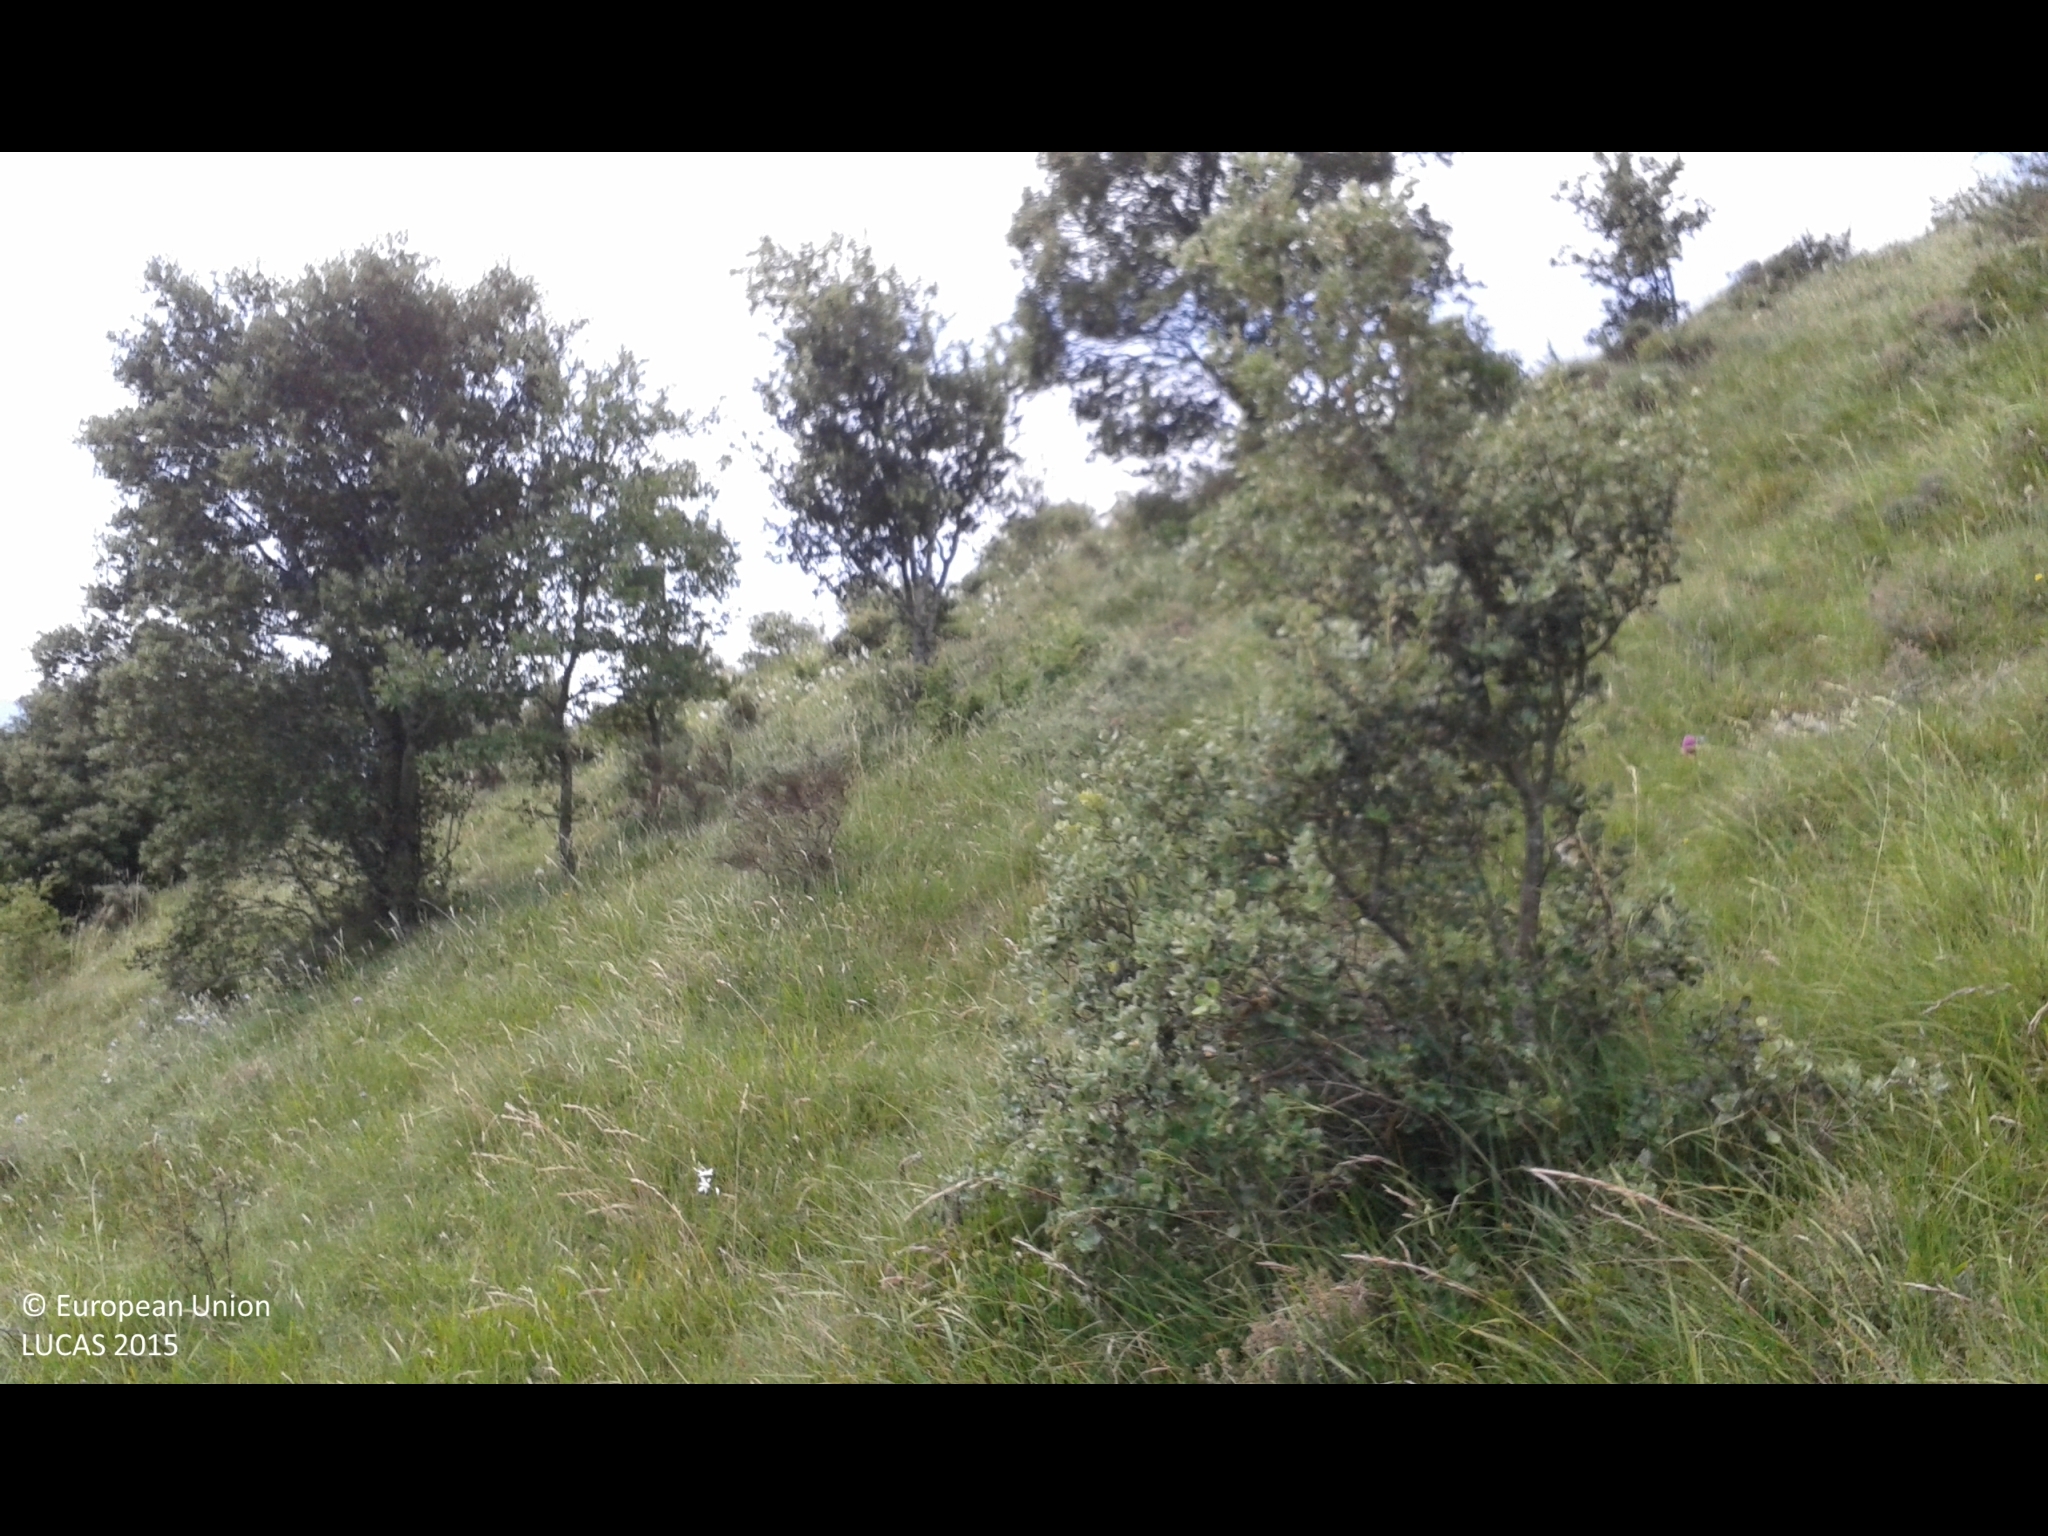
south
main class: Shrubland
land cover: Shrubland with sparse tree cover
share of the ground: > 75 %
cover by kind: herbaceous plants 75 %, shrubs 20 %, broadleaved forest trees 5 %
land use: Agriculture (excluding fallow land and kitchen gardens)
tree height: < 5 m
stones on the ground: < 10 %
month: June
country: ES
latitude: 42.8838
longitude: -1.7086
